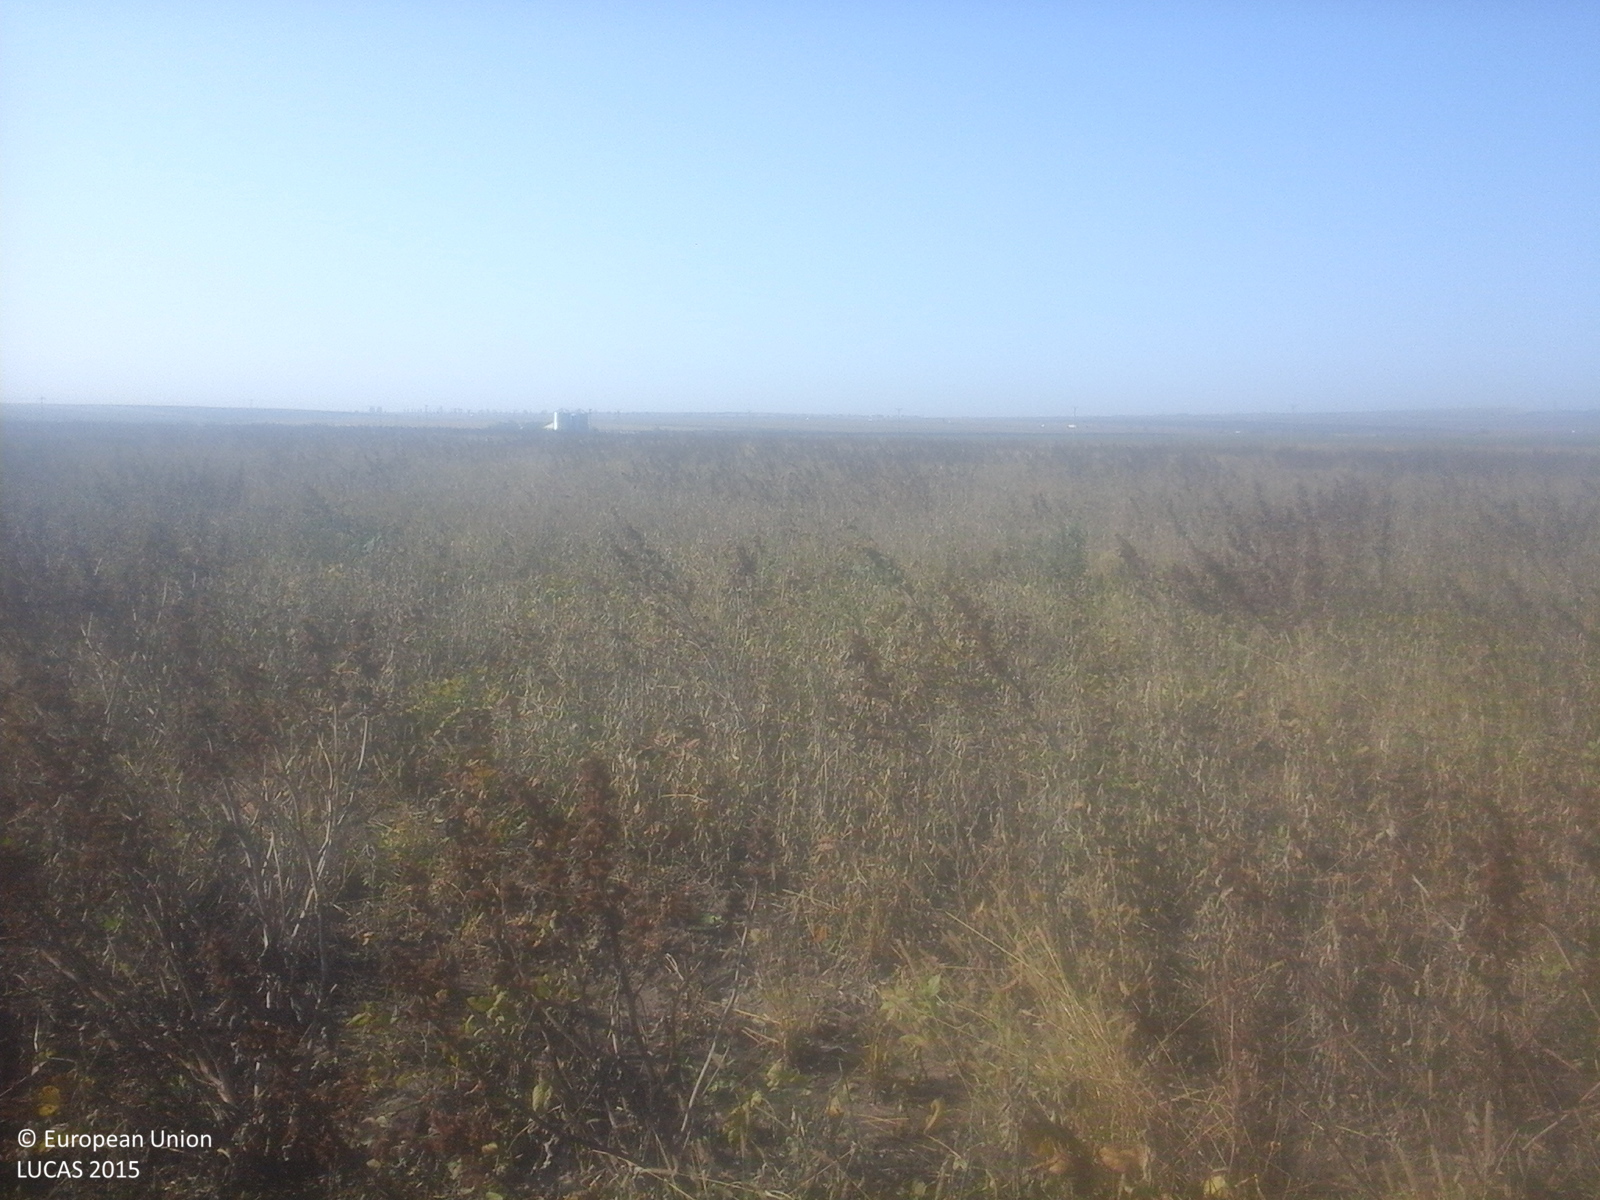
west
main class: Cropland
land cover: Soya
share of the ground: > 75 %
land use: Agriculture (excluding fallow land and kitchen gardens)
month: October
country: RO
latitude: 45.3283
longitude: 26.9917
